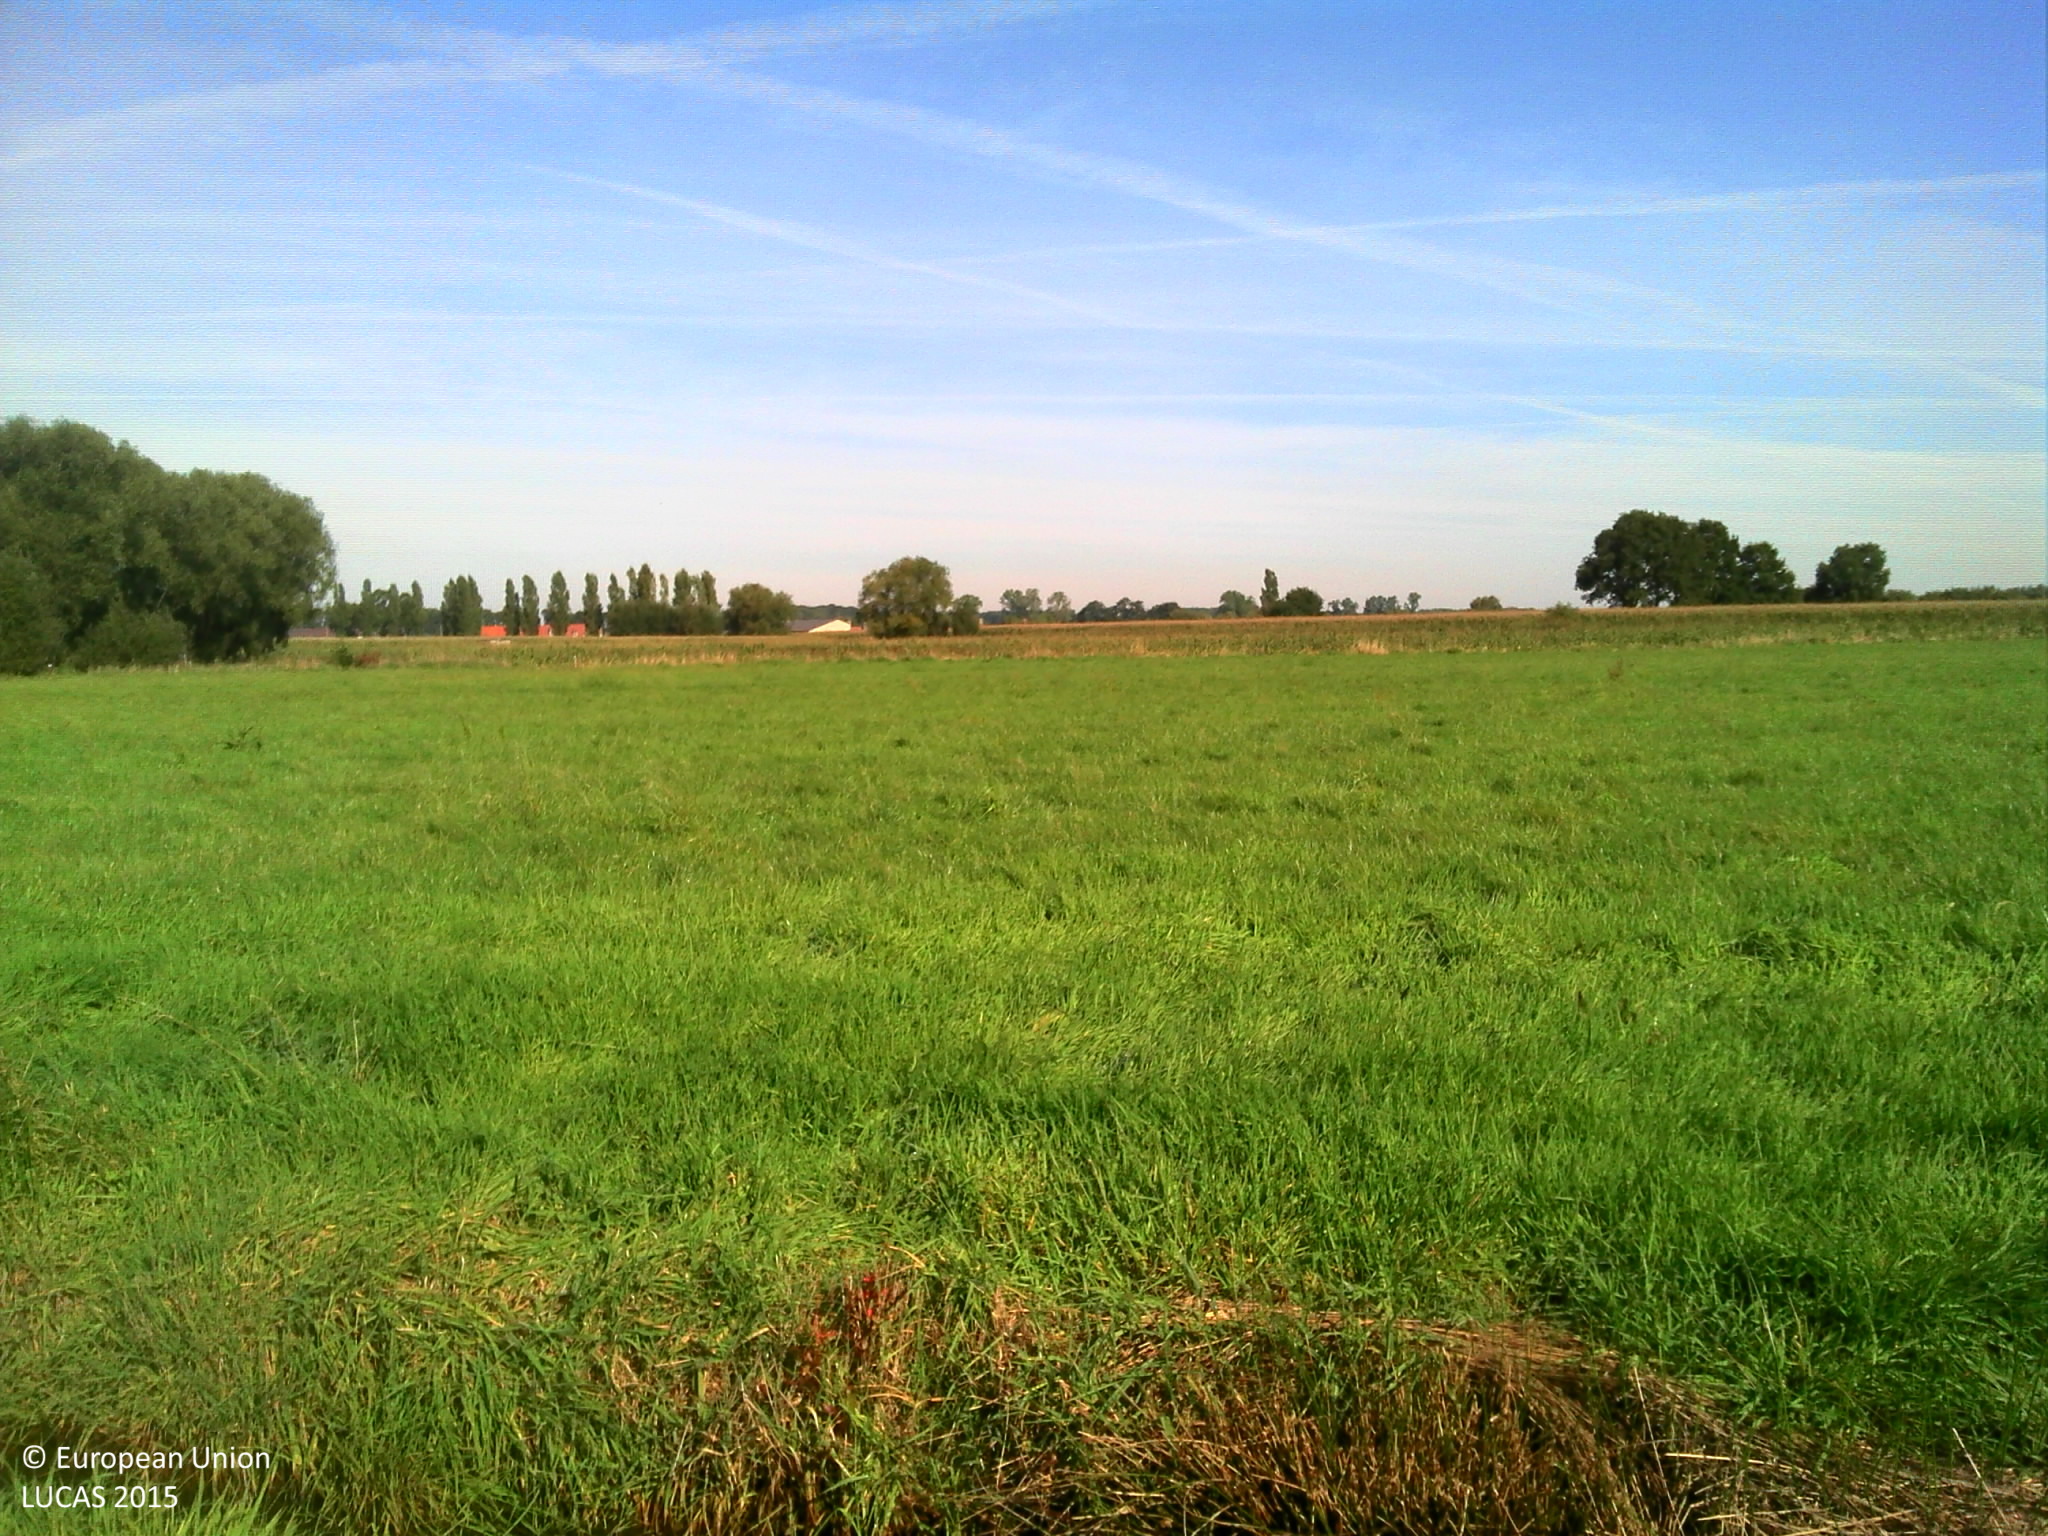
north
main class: Grassland
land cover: Grassland without tree/shrub cover
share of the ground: > 75 %
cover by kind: herbaceous plants 100 %
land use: Agriculture (excluding fallow land and kitchen gardens)
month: September
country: BE
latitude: 51.1477
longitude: 3.4016
